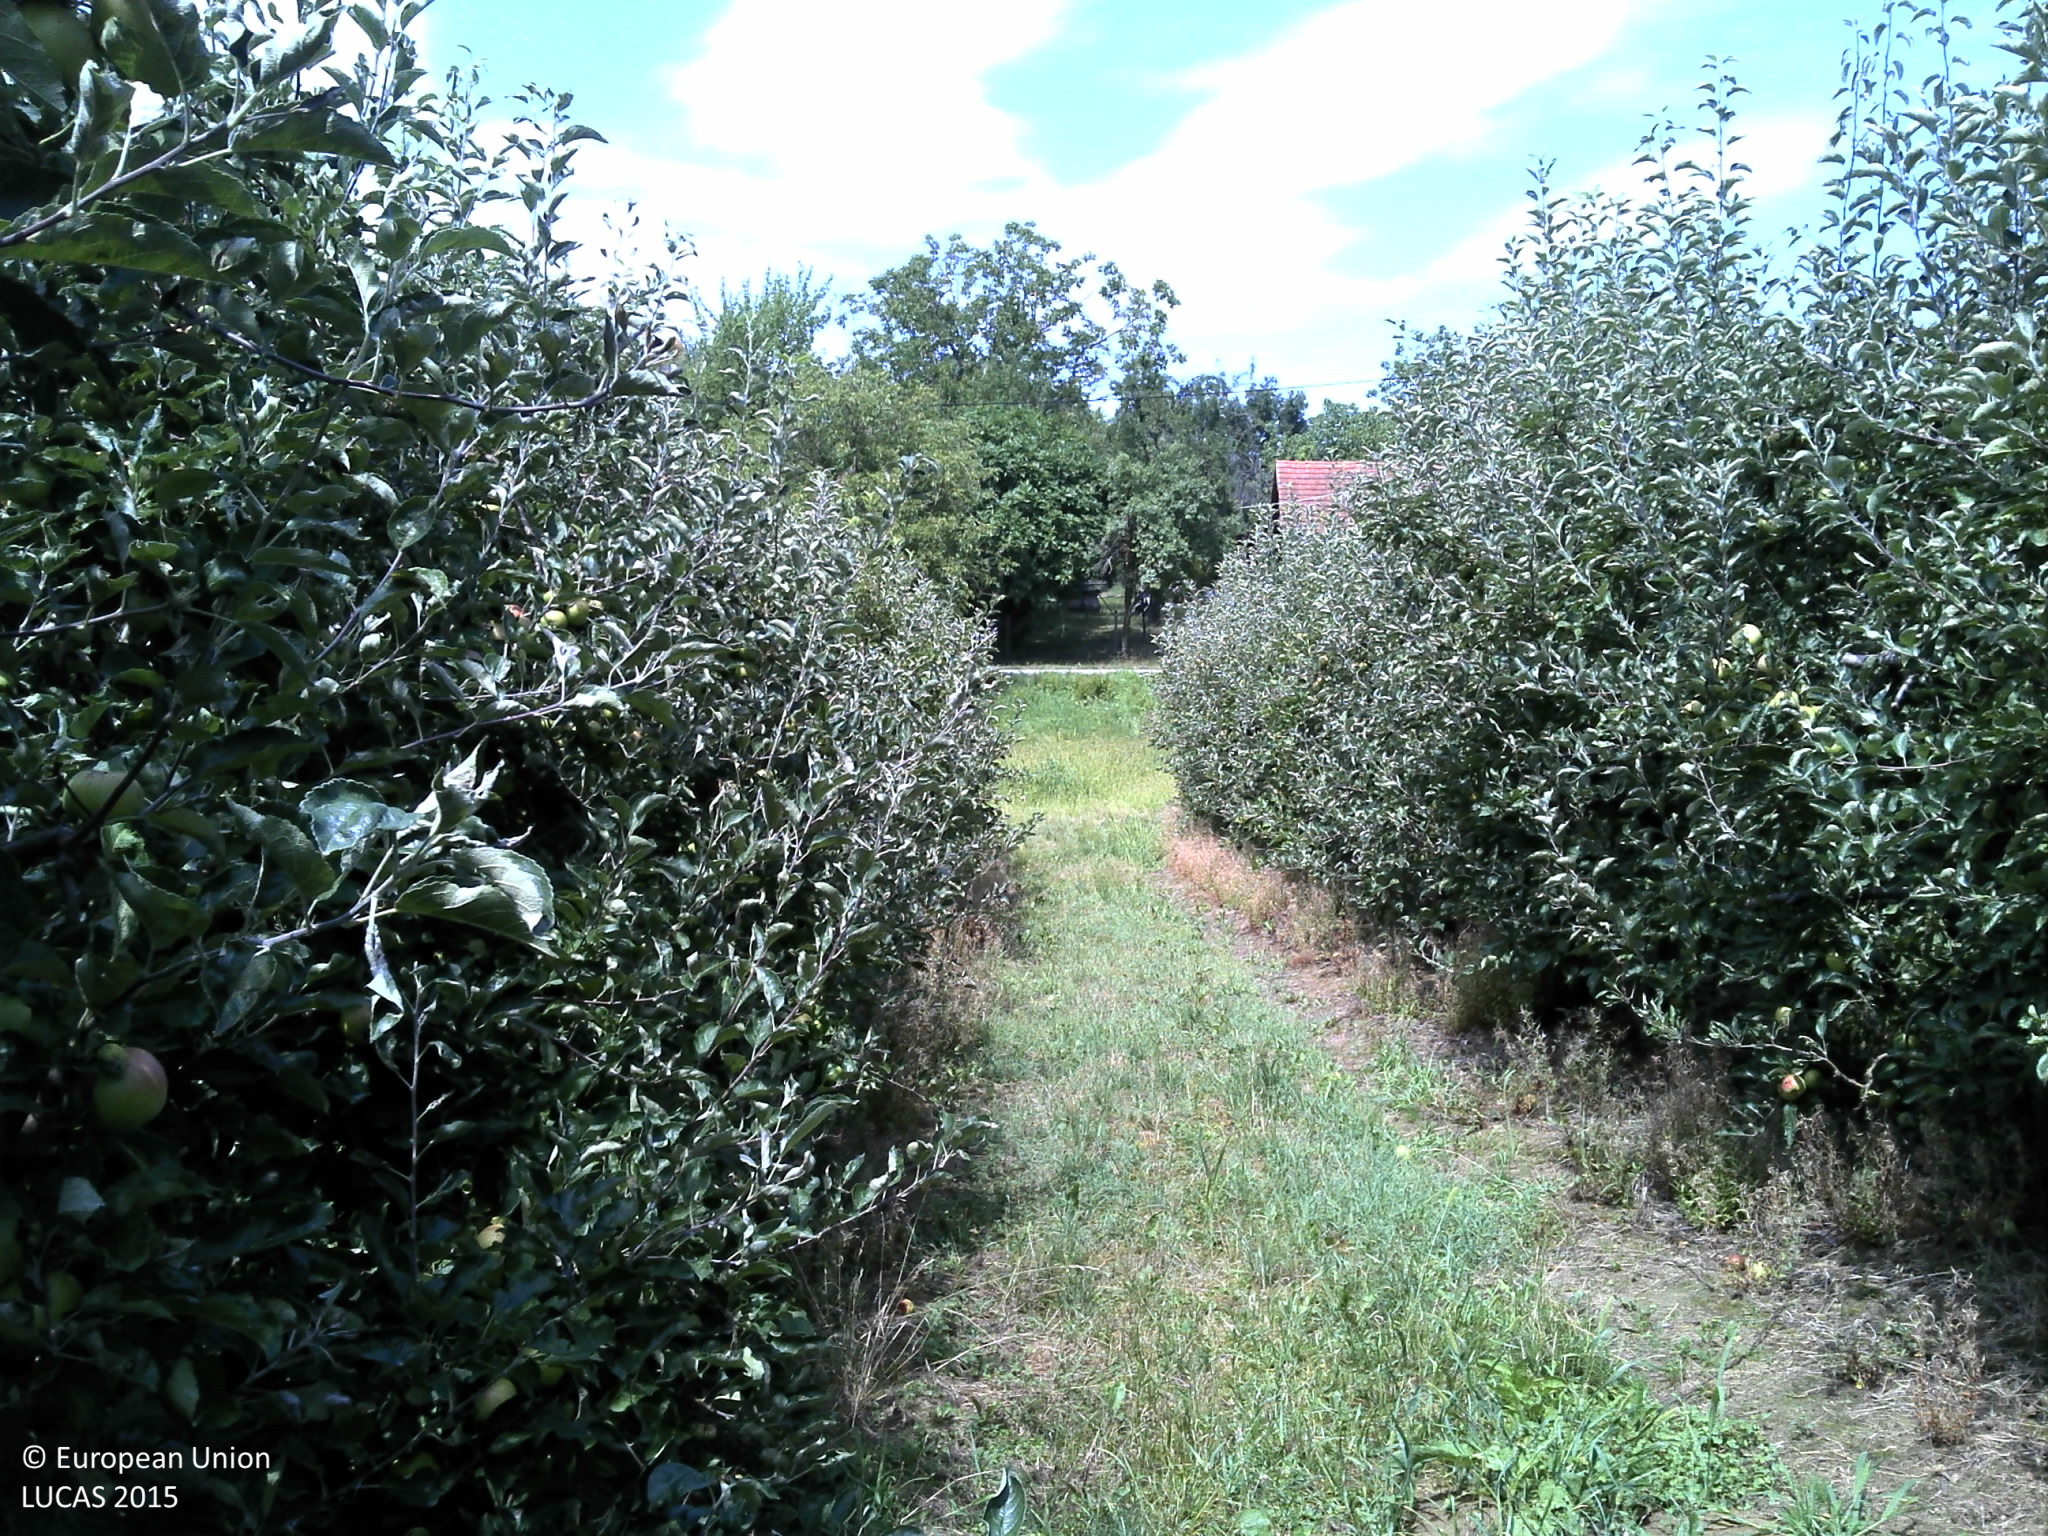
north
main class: Cropland
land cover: Apple fruit
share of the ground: > 75 %
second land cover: Spontaneously vegetated surfaces
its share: > 75 %
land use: Kitchen garden
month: July
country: HR
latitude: 45.6393
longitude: 16.6318
